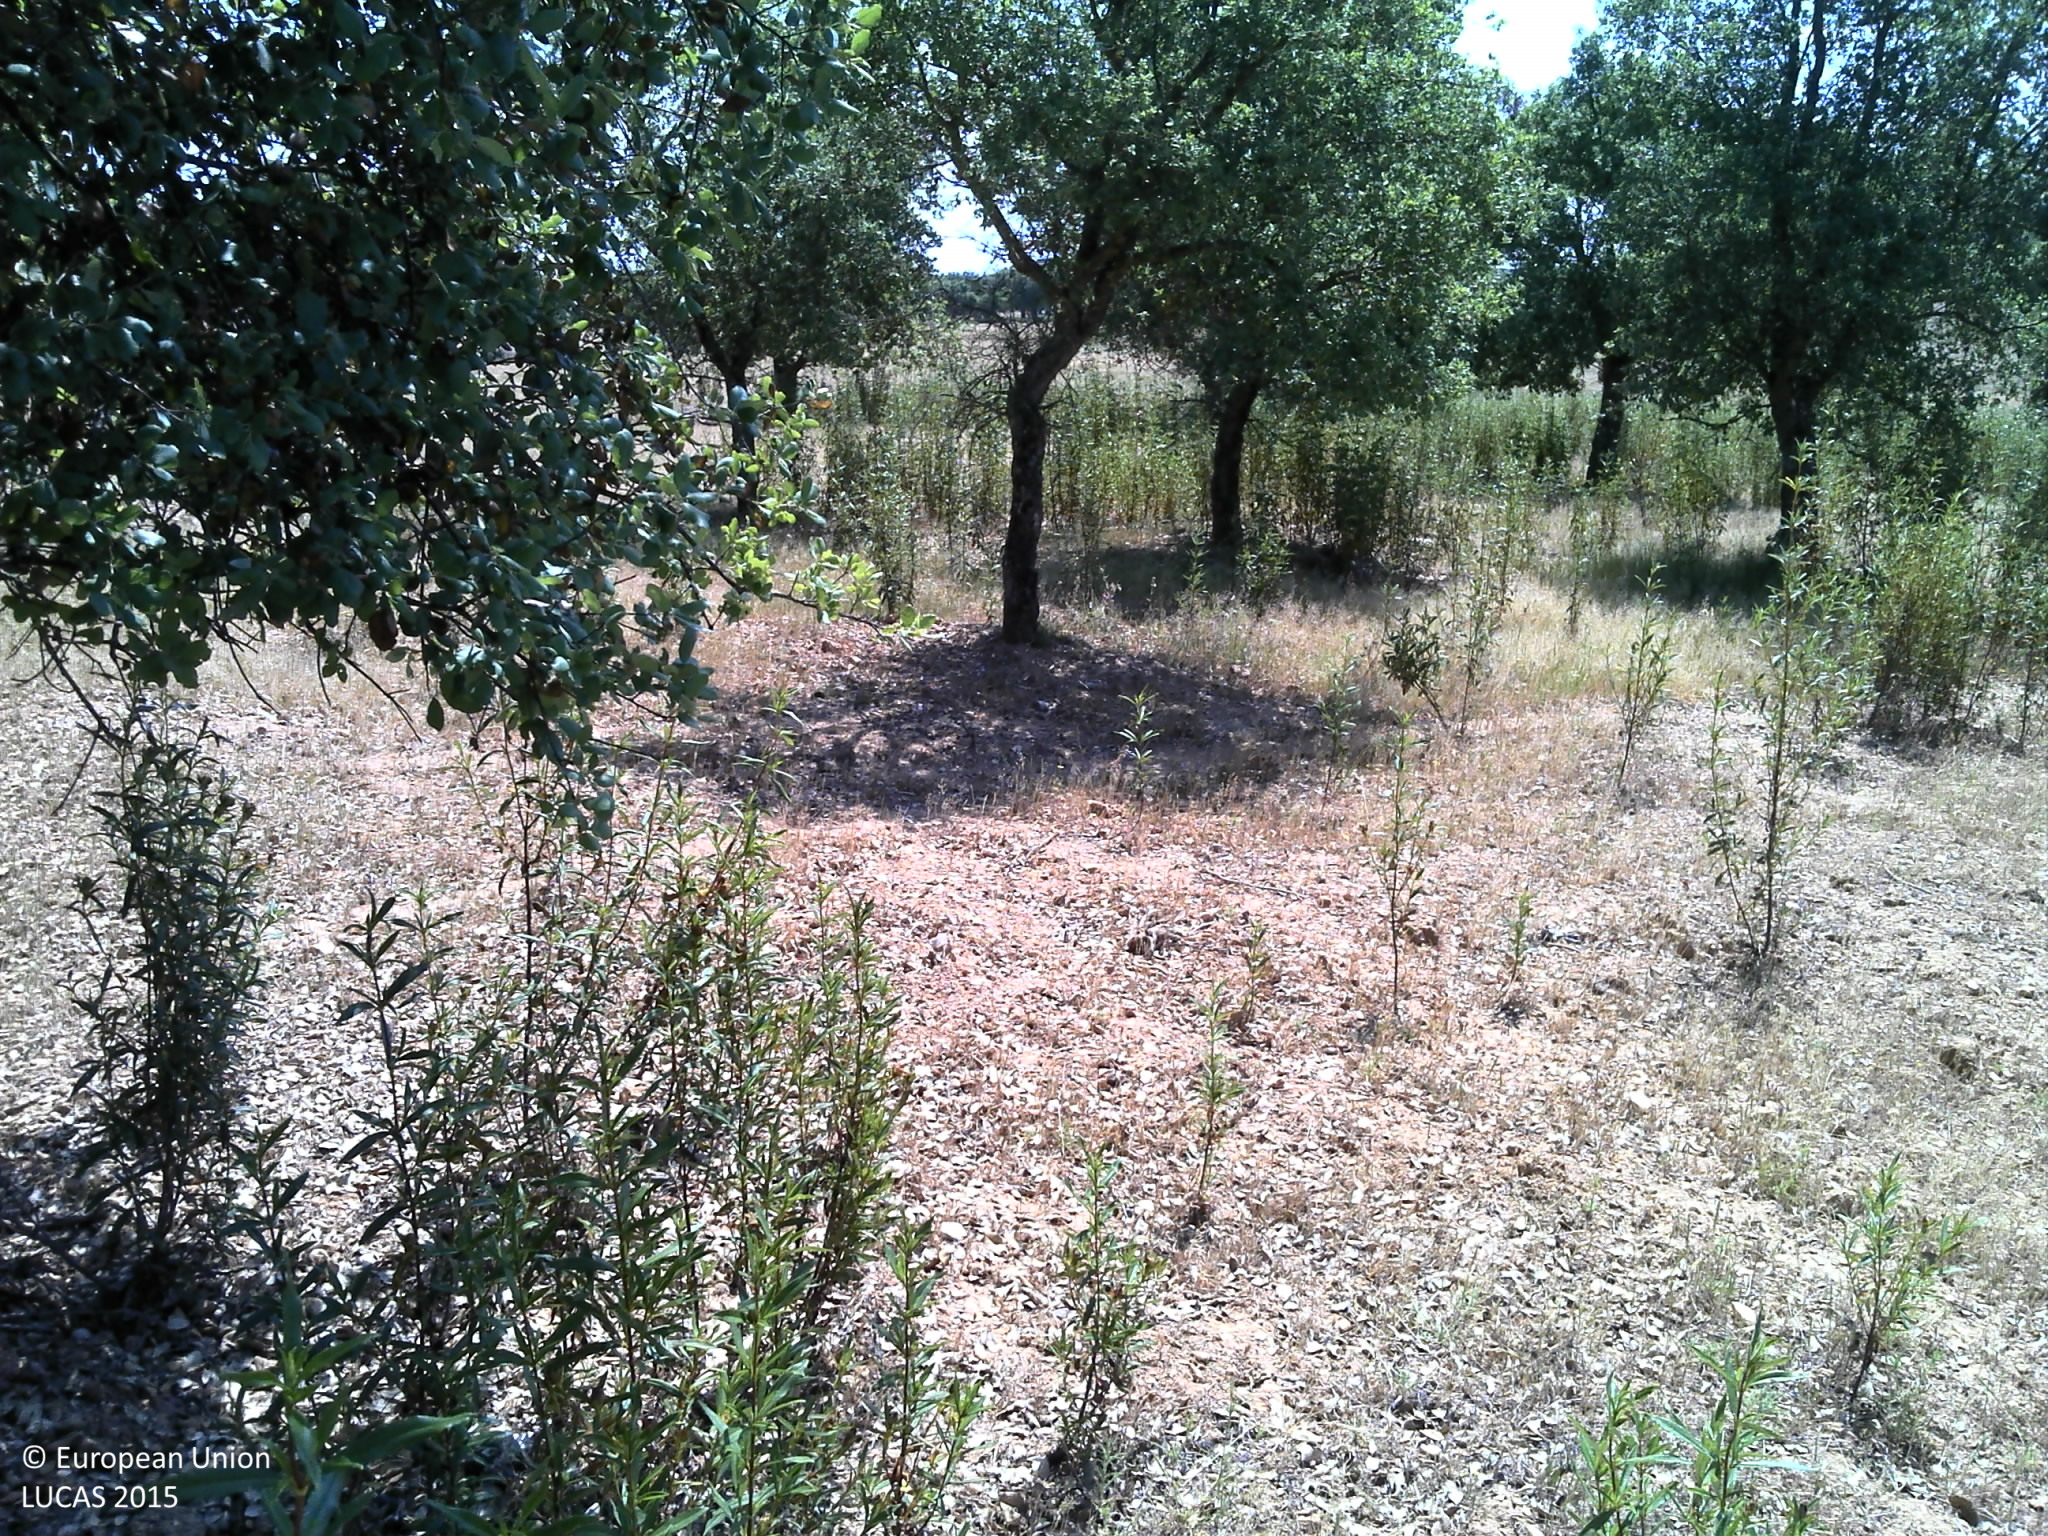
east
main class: Woodland
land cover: Broadleaved woodland
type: broadleaved evergreen forest
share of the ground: 50 - 75 %
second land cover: Shrubland without tree cover
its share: 10 - 25 %
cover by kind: broadleaved forest trees 60 %, shrubs 20 %, herbaceous plants 10 %, unconsolidated bare surface 10 %
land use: Forestry
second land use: Agriculture (excluding fallow land and kitchen gardens)
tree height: < 5 m
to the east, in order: Broadleaved woodland; Shrubland without tree cover; Grassland without tree/shrub cover; Single bushes/trees; Grassland without tree/shrub cover
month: May
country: PT
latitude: 37.8634
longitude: -8.5816
